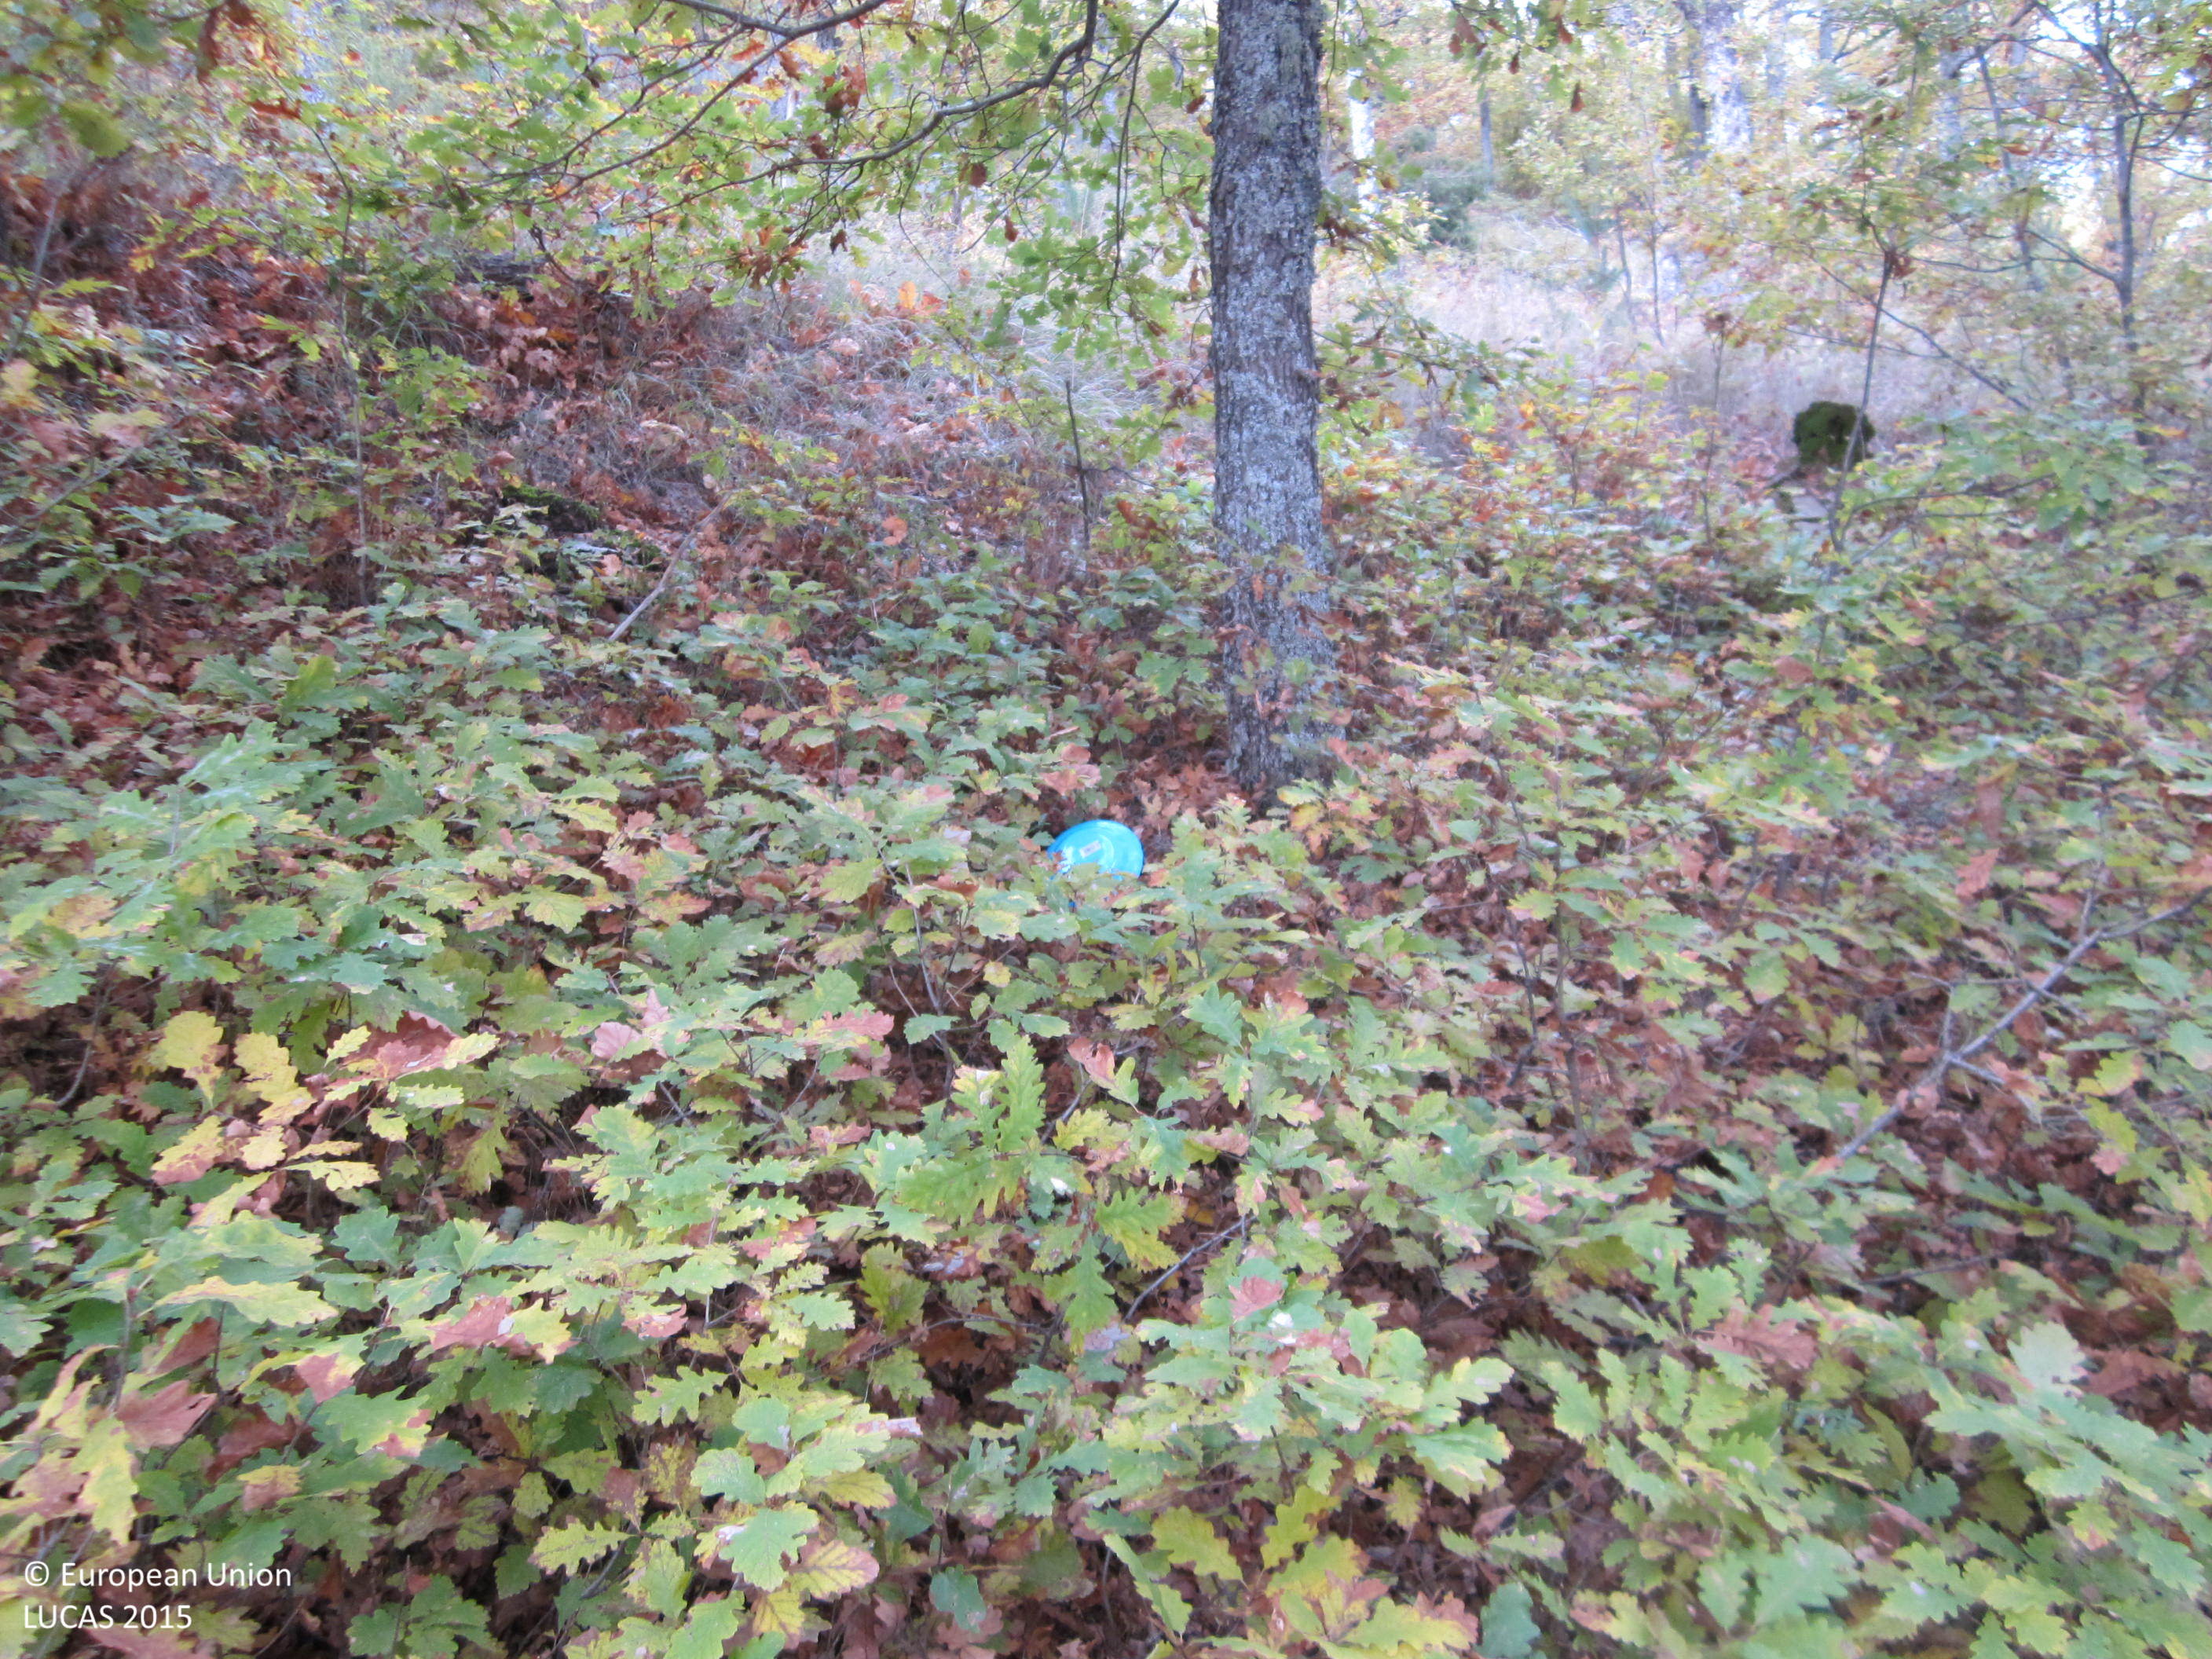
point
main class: Woodland
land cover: Broadleaved woodland
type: acidophilous oak and oak-birch forest
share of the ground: > 75 %
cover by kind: broadleaved forest trees 90 %, shrubs 5 %, herbaceous plants 5 %
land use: Forestry
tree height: > 5 m
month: November
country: BG
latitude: 41.3632
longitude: 25.8301
